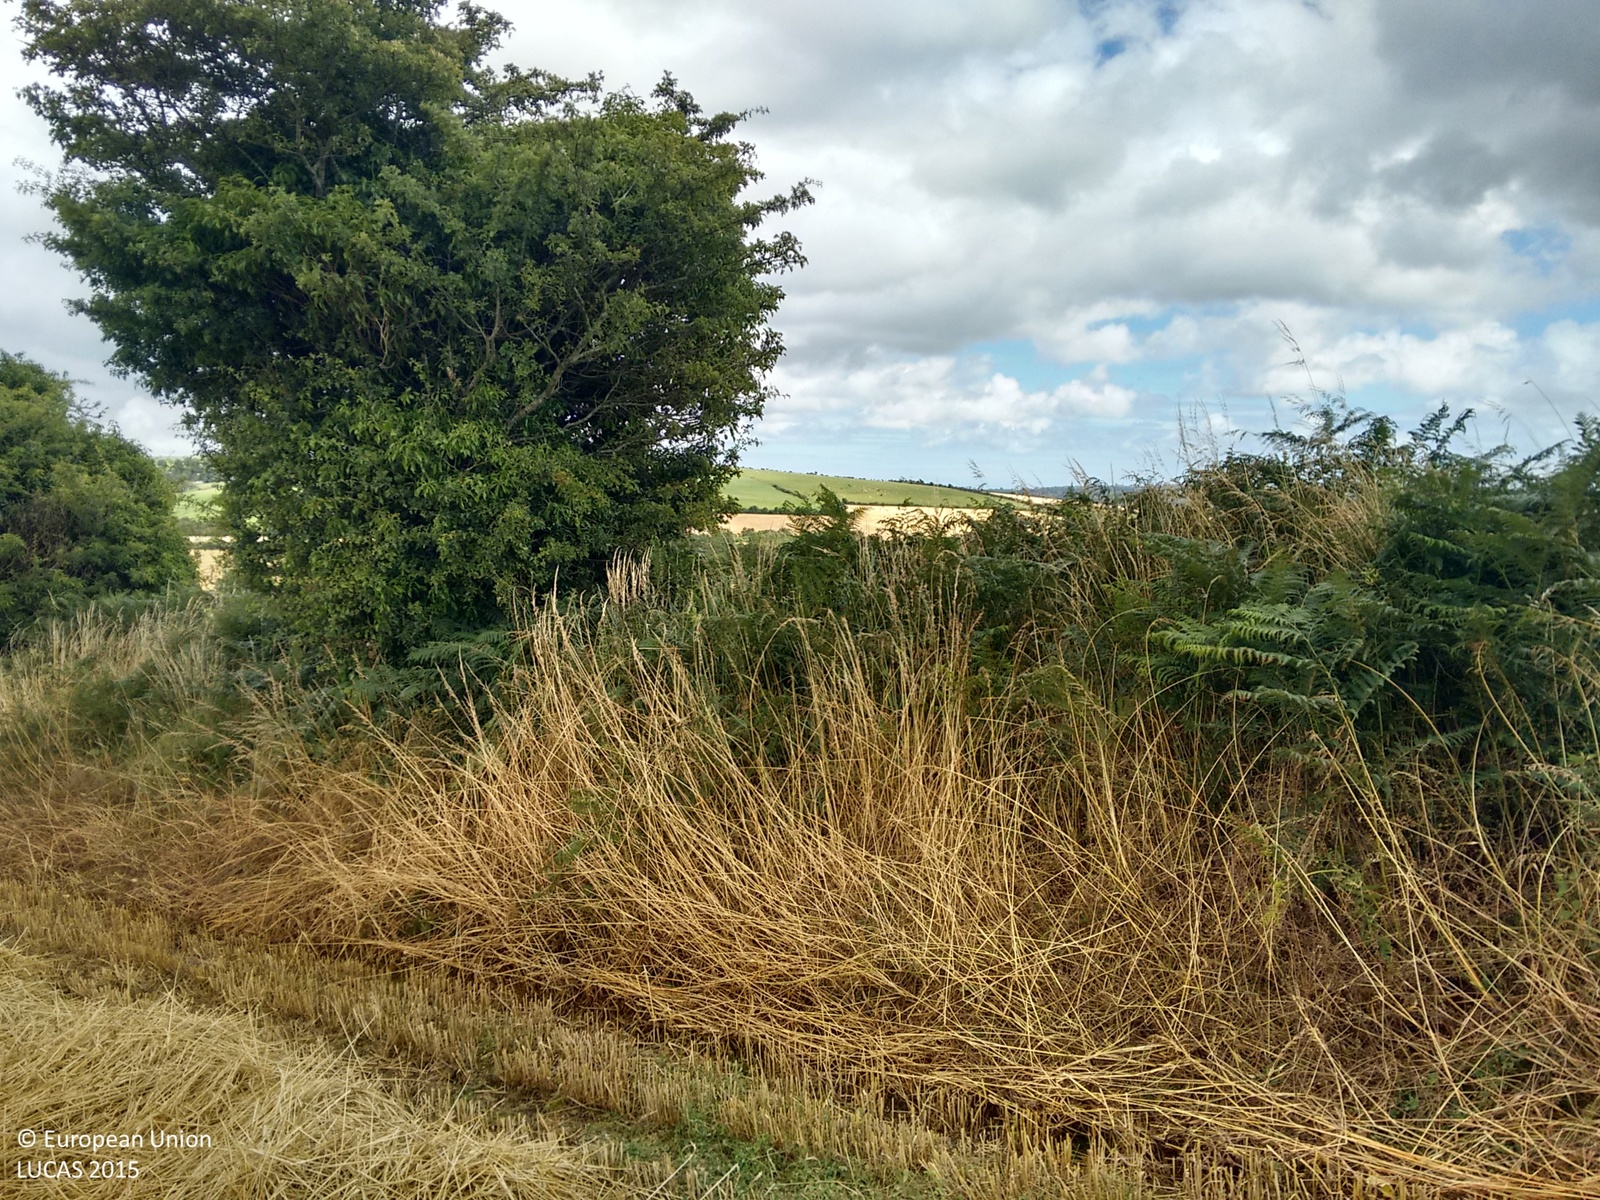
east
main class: Cropland
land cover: Barley
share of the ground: > 75 %
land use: Agriculture (excluding fallow land and kitchen gardens)
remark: Harvested field
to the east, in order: Barley; Abandoned hedges; Barley
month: August
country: IE
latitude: 52.6715
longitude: -6.4375
